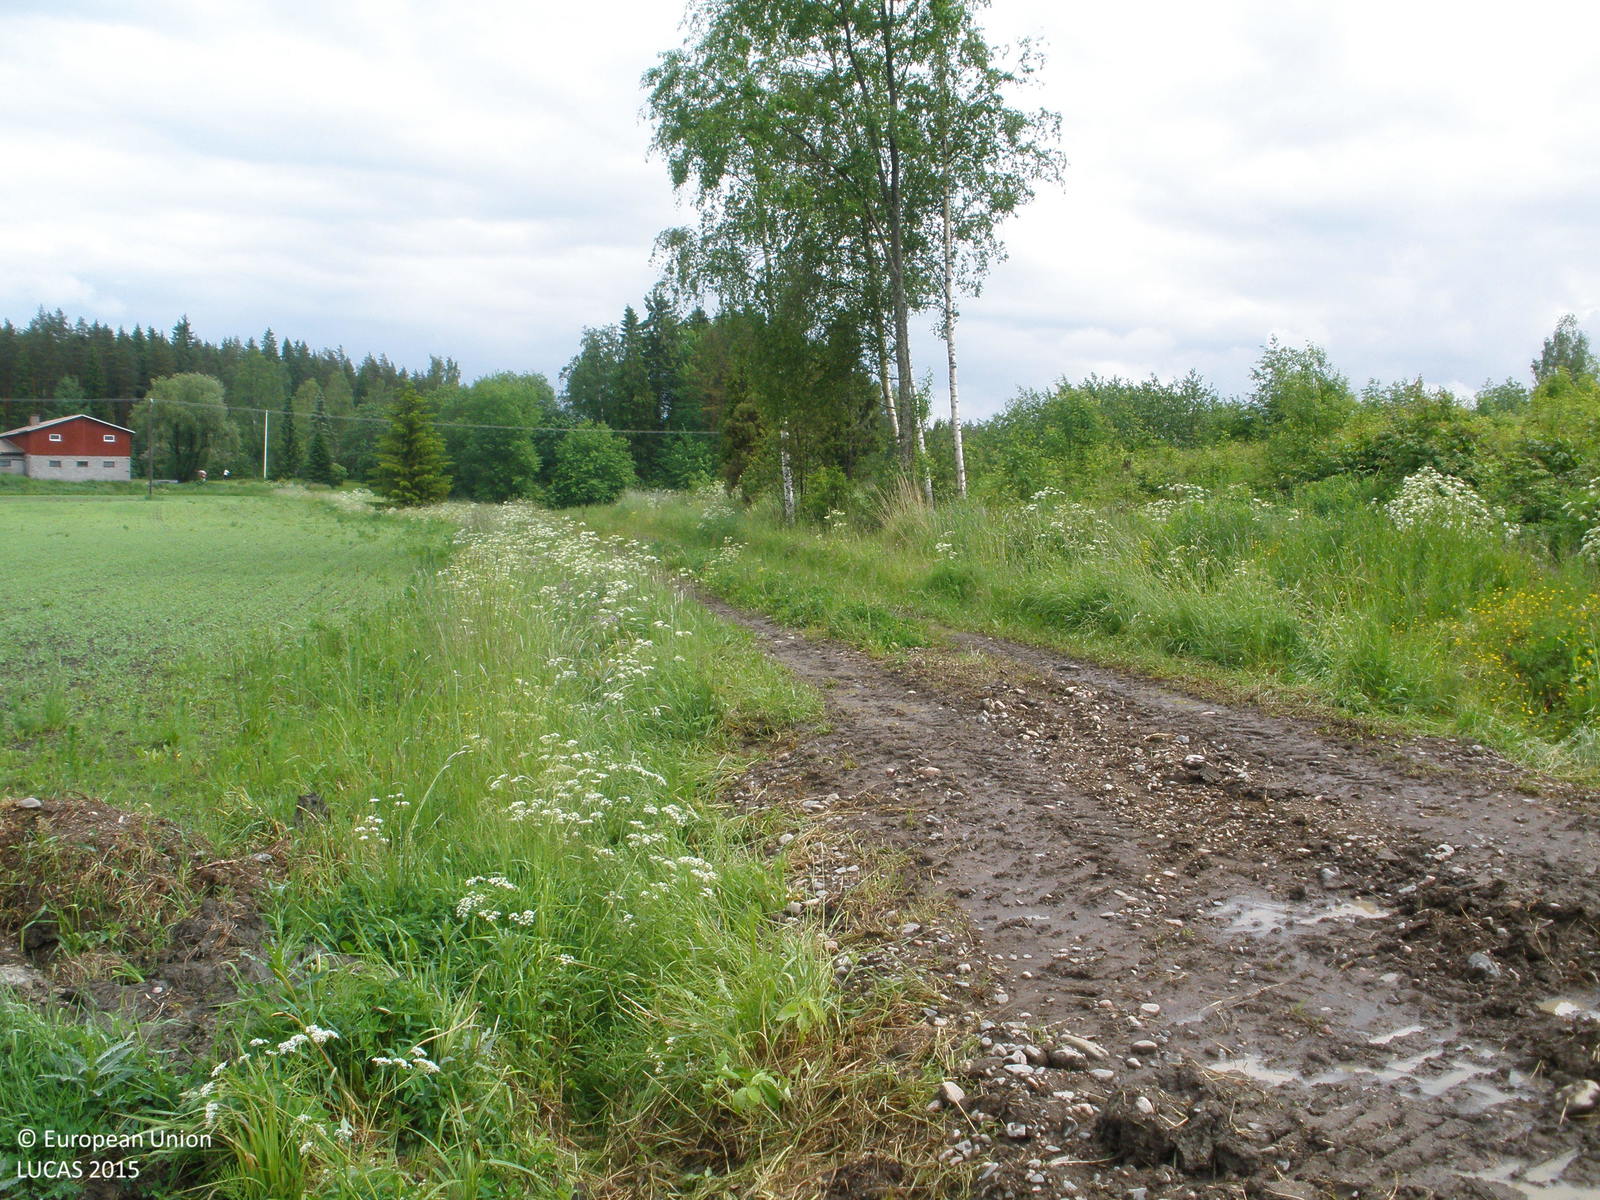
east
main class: Cropland
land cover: Oats
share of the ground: 25 - 50 %
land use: Agriculture (excluding fallow land and kitchen gardens)
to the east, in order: Oats; Grass margins; Ditches and canals; Grass margins; Barley; Electric lines; Grassland without tree/shrub cover; Artificial constructions in urban areas; Grassland with sparse tree/shrub cover; Paved roads, cycling and walking lanes; Abandoned hedges; Oats
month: June
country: FI
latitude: 60.8142
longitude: 23.4485
